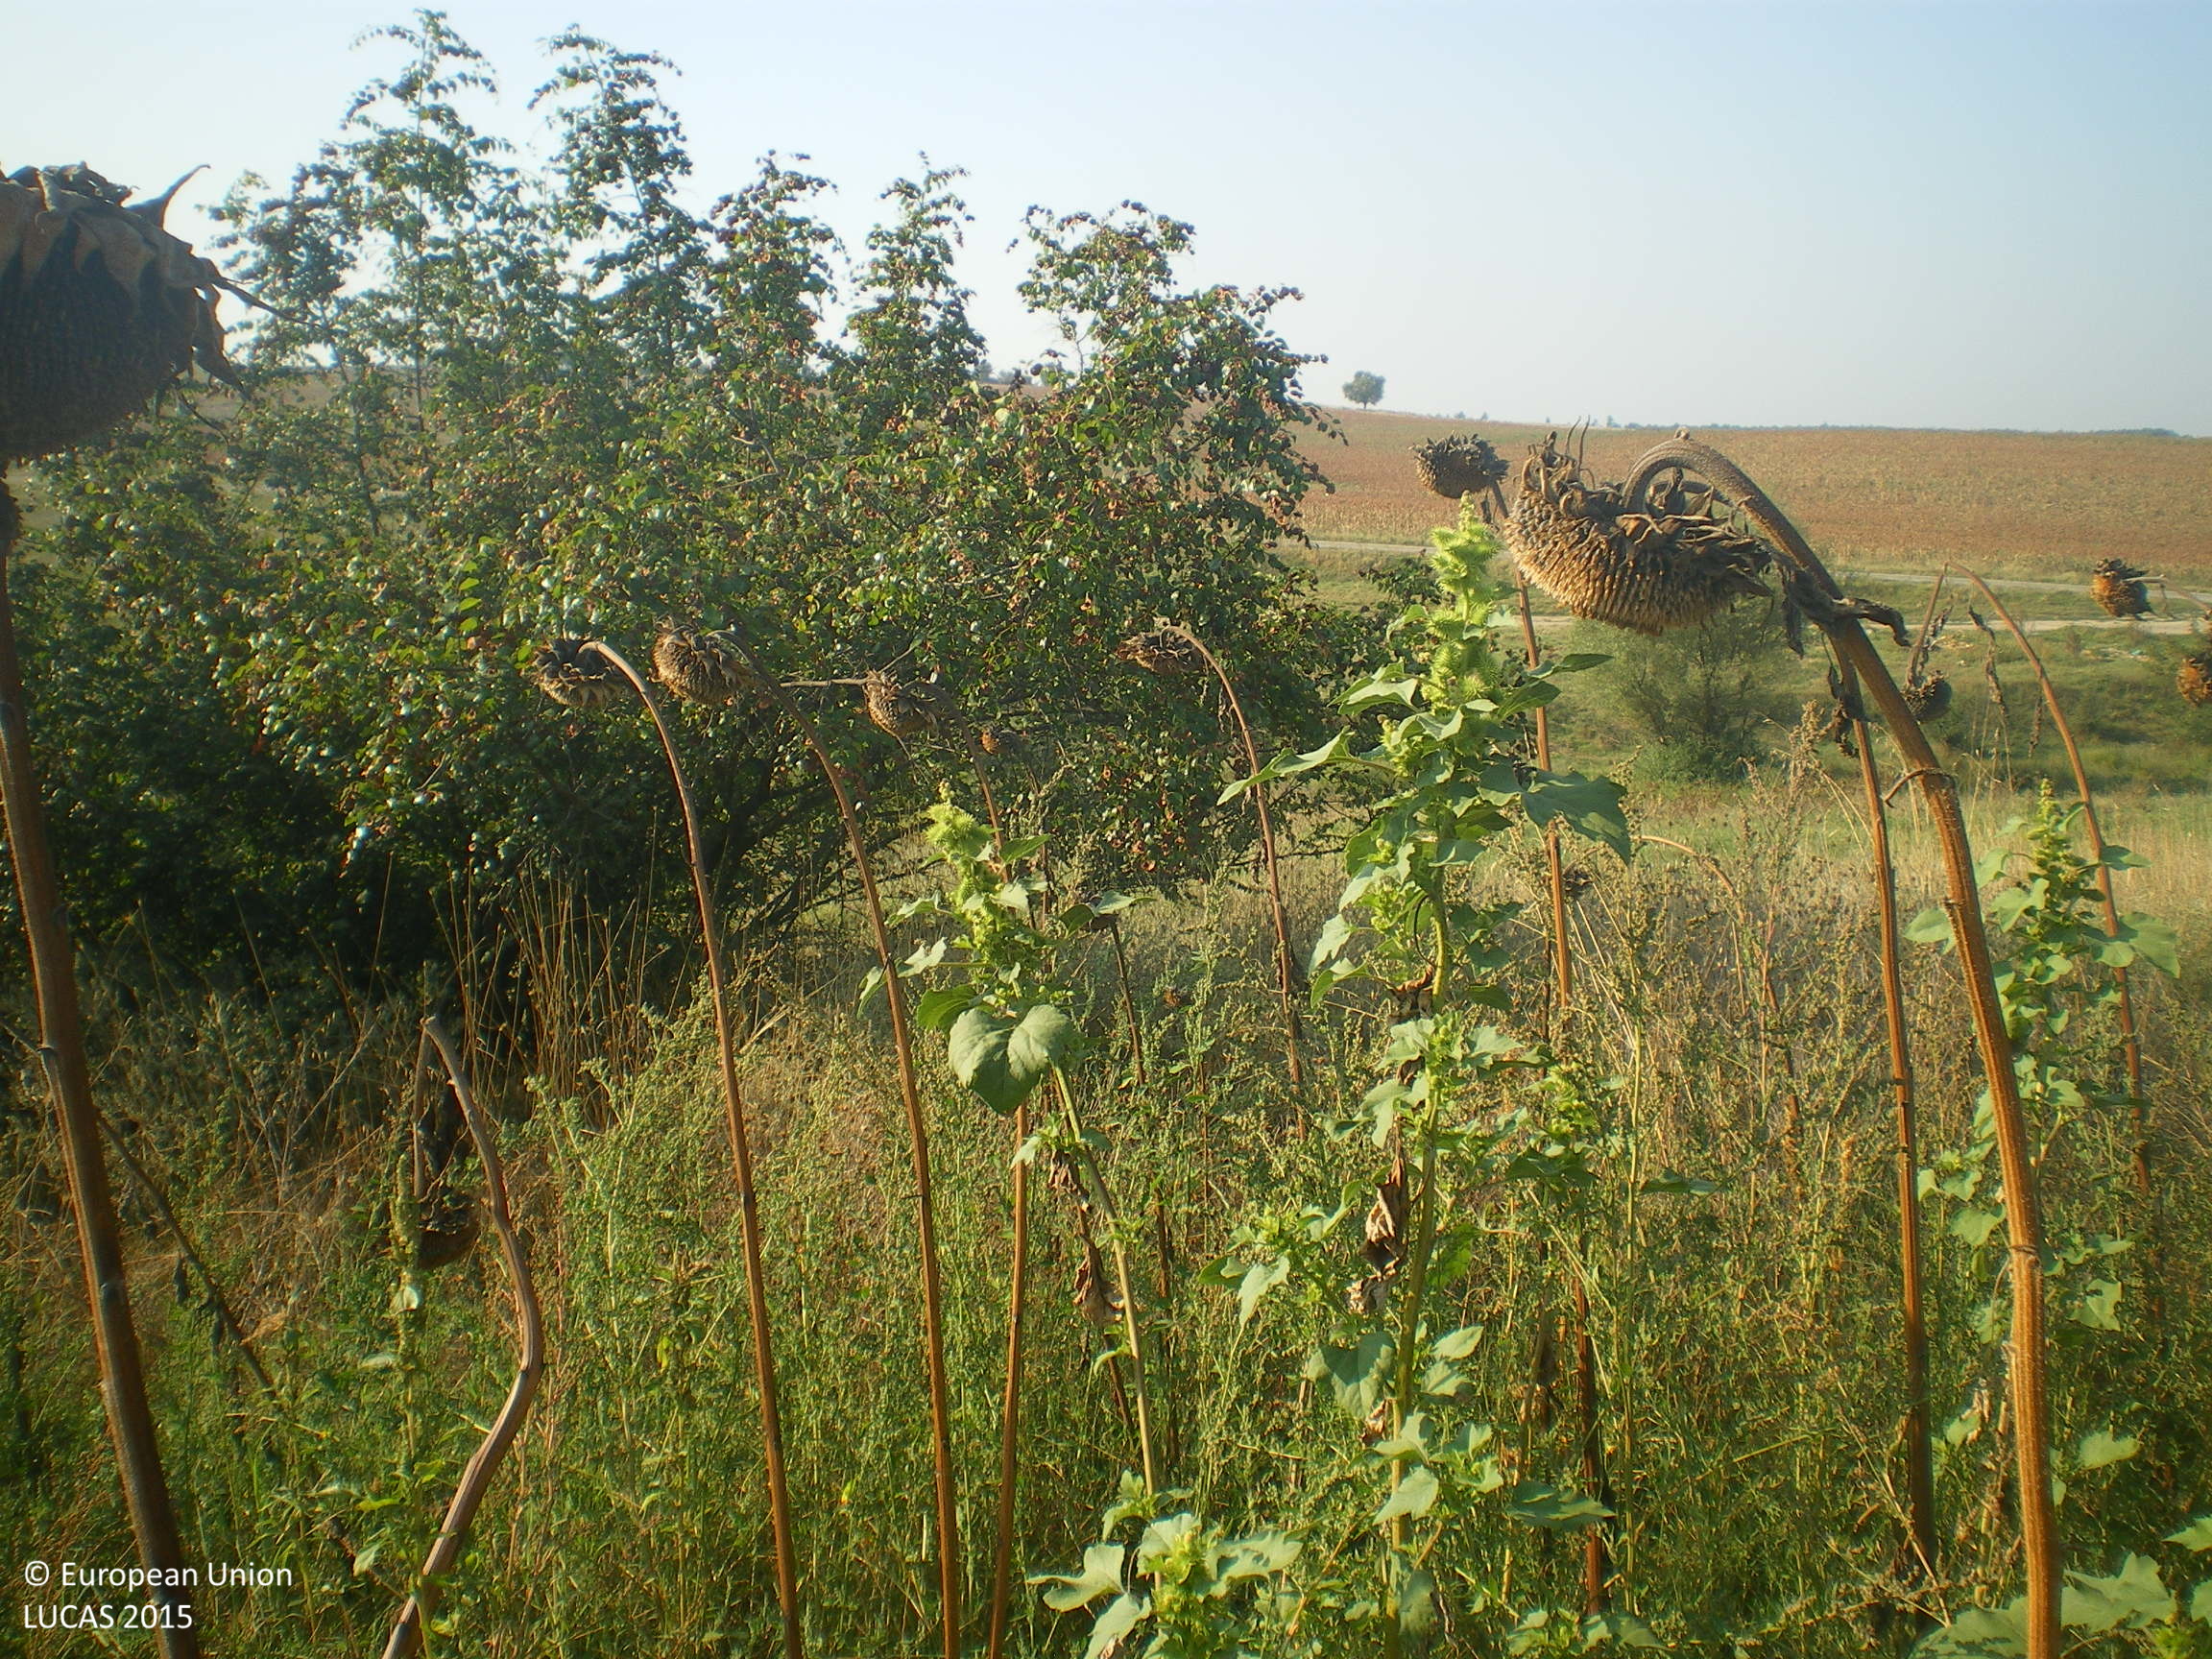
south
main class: Cropland
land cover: Sunflower
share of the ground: > 75 %
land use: Agriculture (excluding fallow land and kitchen gardens)
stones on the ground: > 50 %
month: August
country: BG
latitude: 42.0266
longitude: 25.9315
